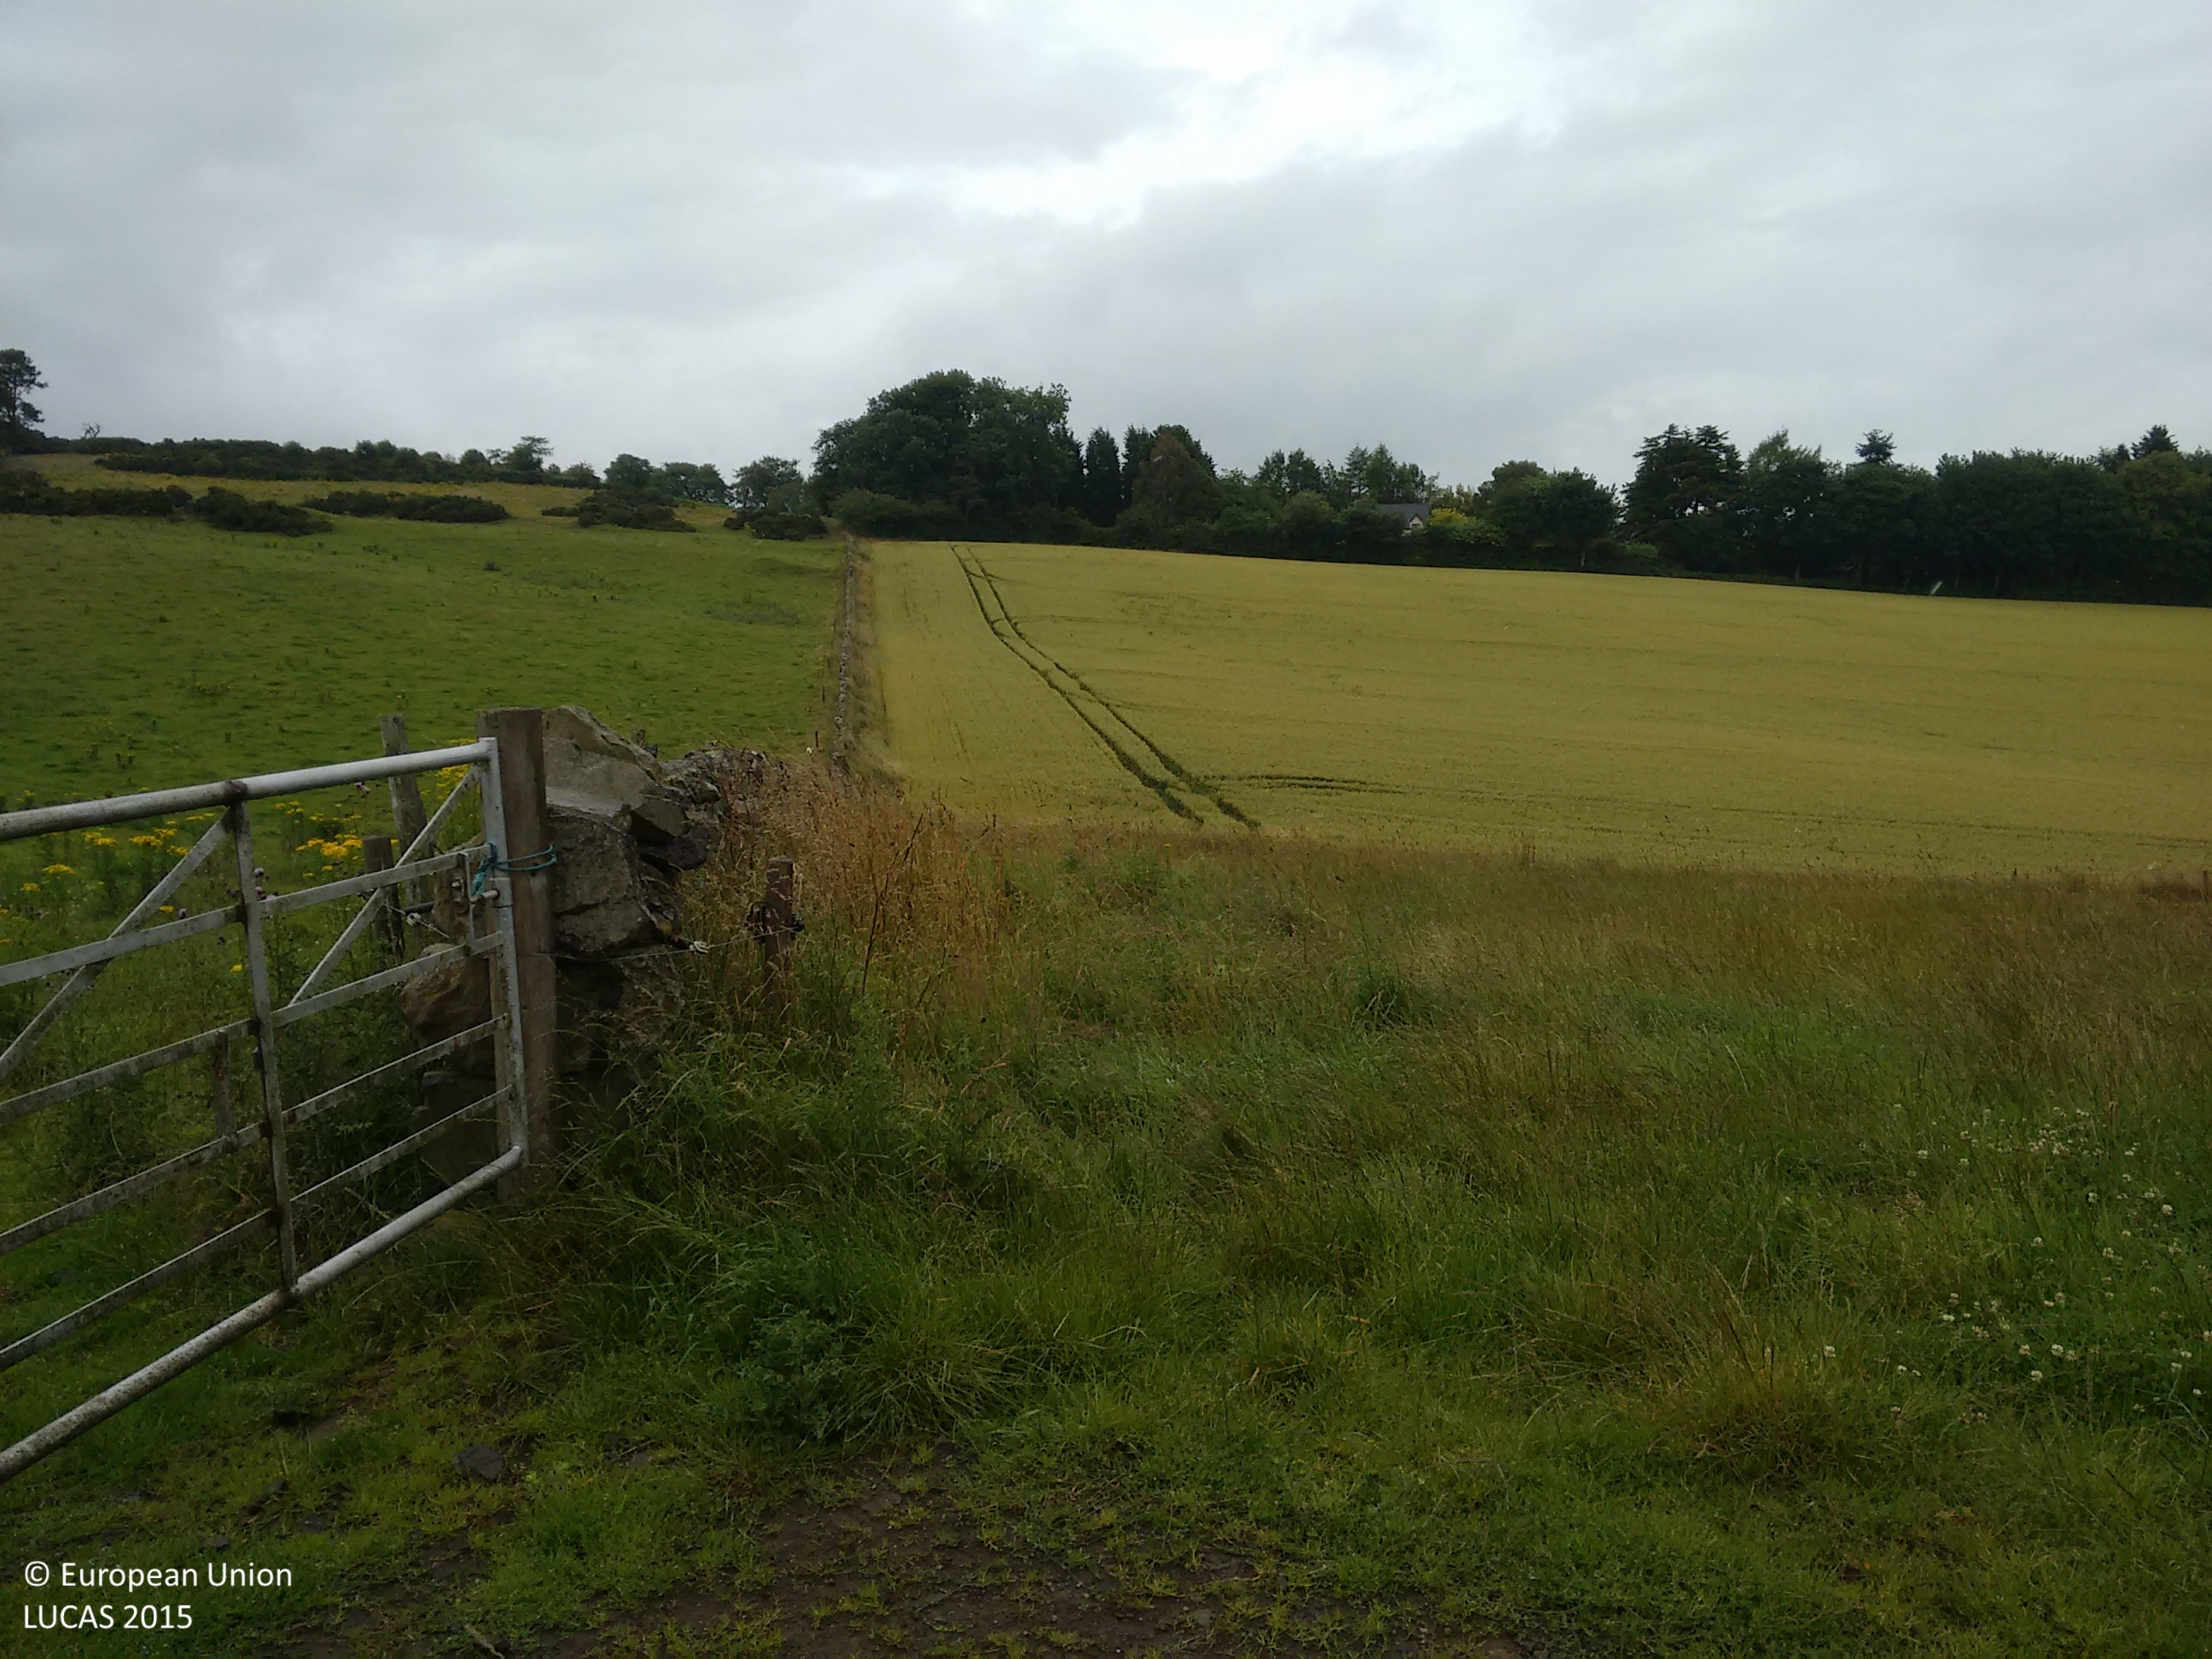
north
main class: Grassland
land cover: Grassland without tree/shrub cover
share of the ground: > 75 %
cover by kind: herbaceous plants 100 %
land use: Agriculture (excluding fallow land and kitchen gardens)
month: July
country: GB
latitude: 56.3698
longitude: -3.1010
